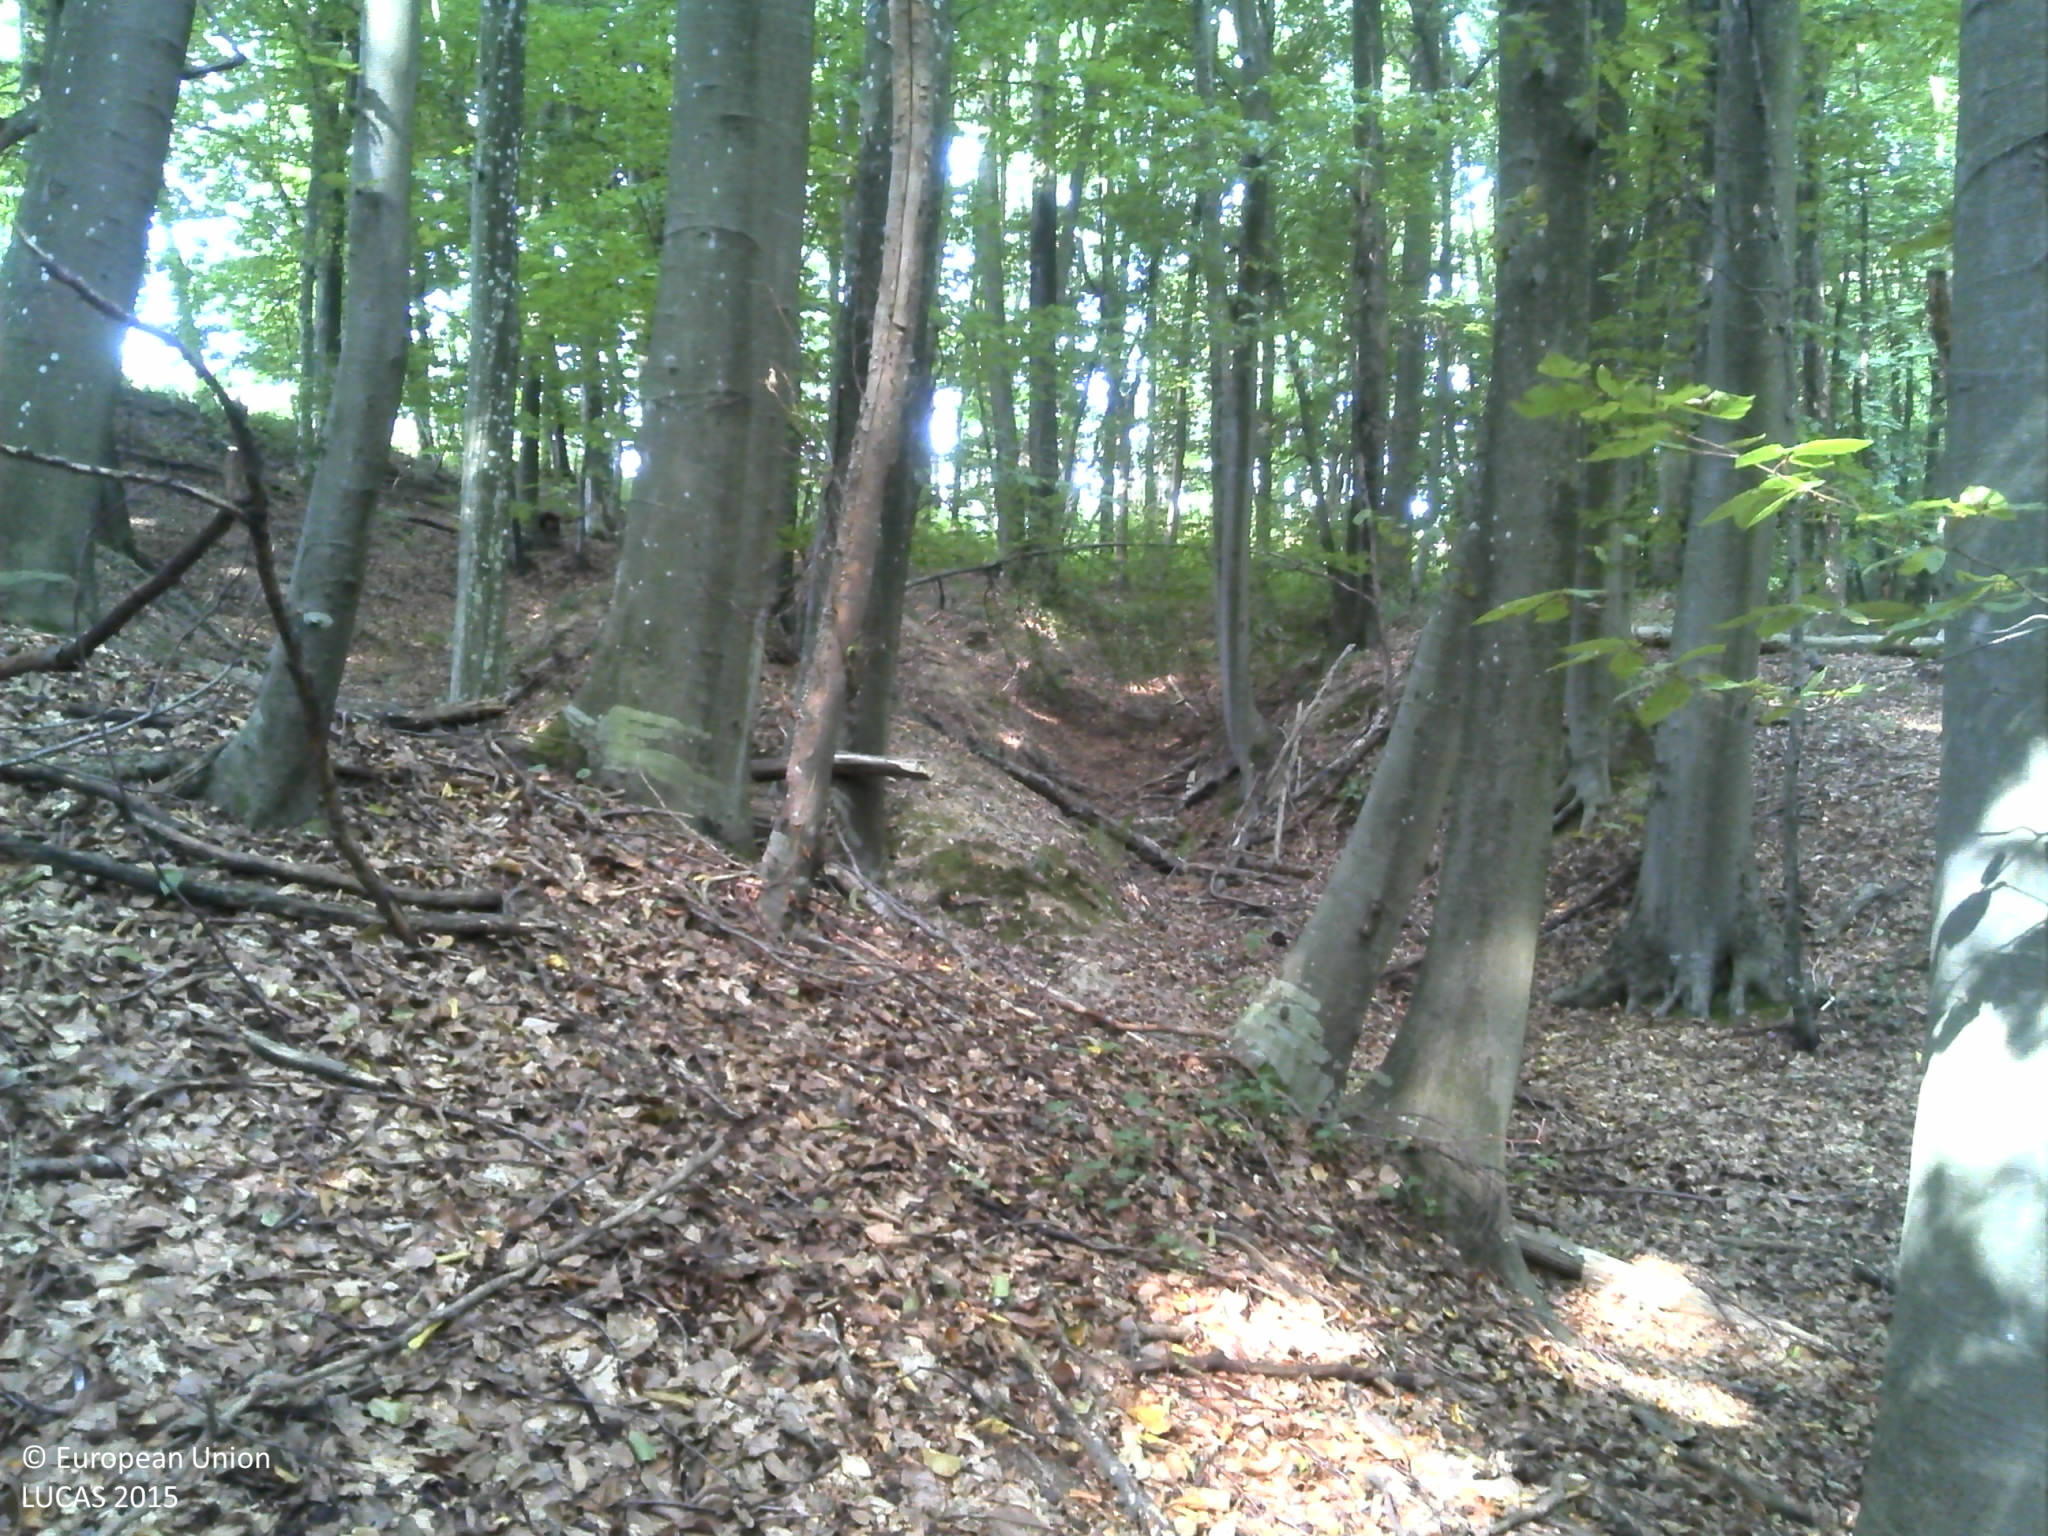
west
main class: Woodland
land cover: Broadleaved woodland
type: acidophilous oak and oak-birch forest
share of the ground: > 75 %
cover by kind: broadleaved forest trees 100 %
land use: Forestry
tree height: > 5 m
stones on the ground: < 10 %
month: September
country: HR
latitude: 45.7353
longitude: 16.5403
